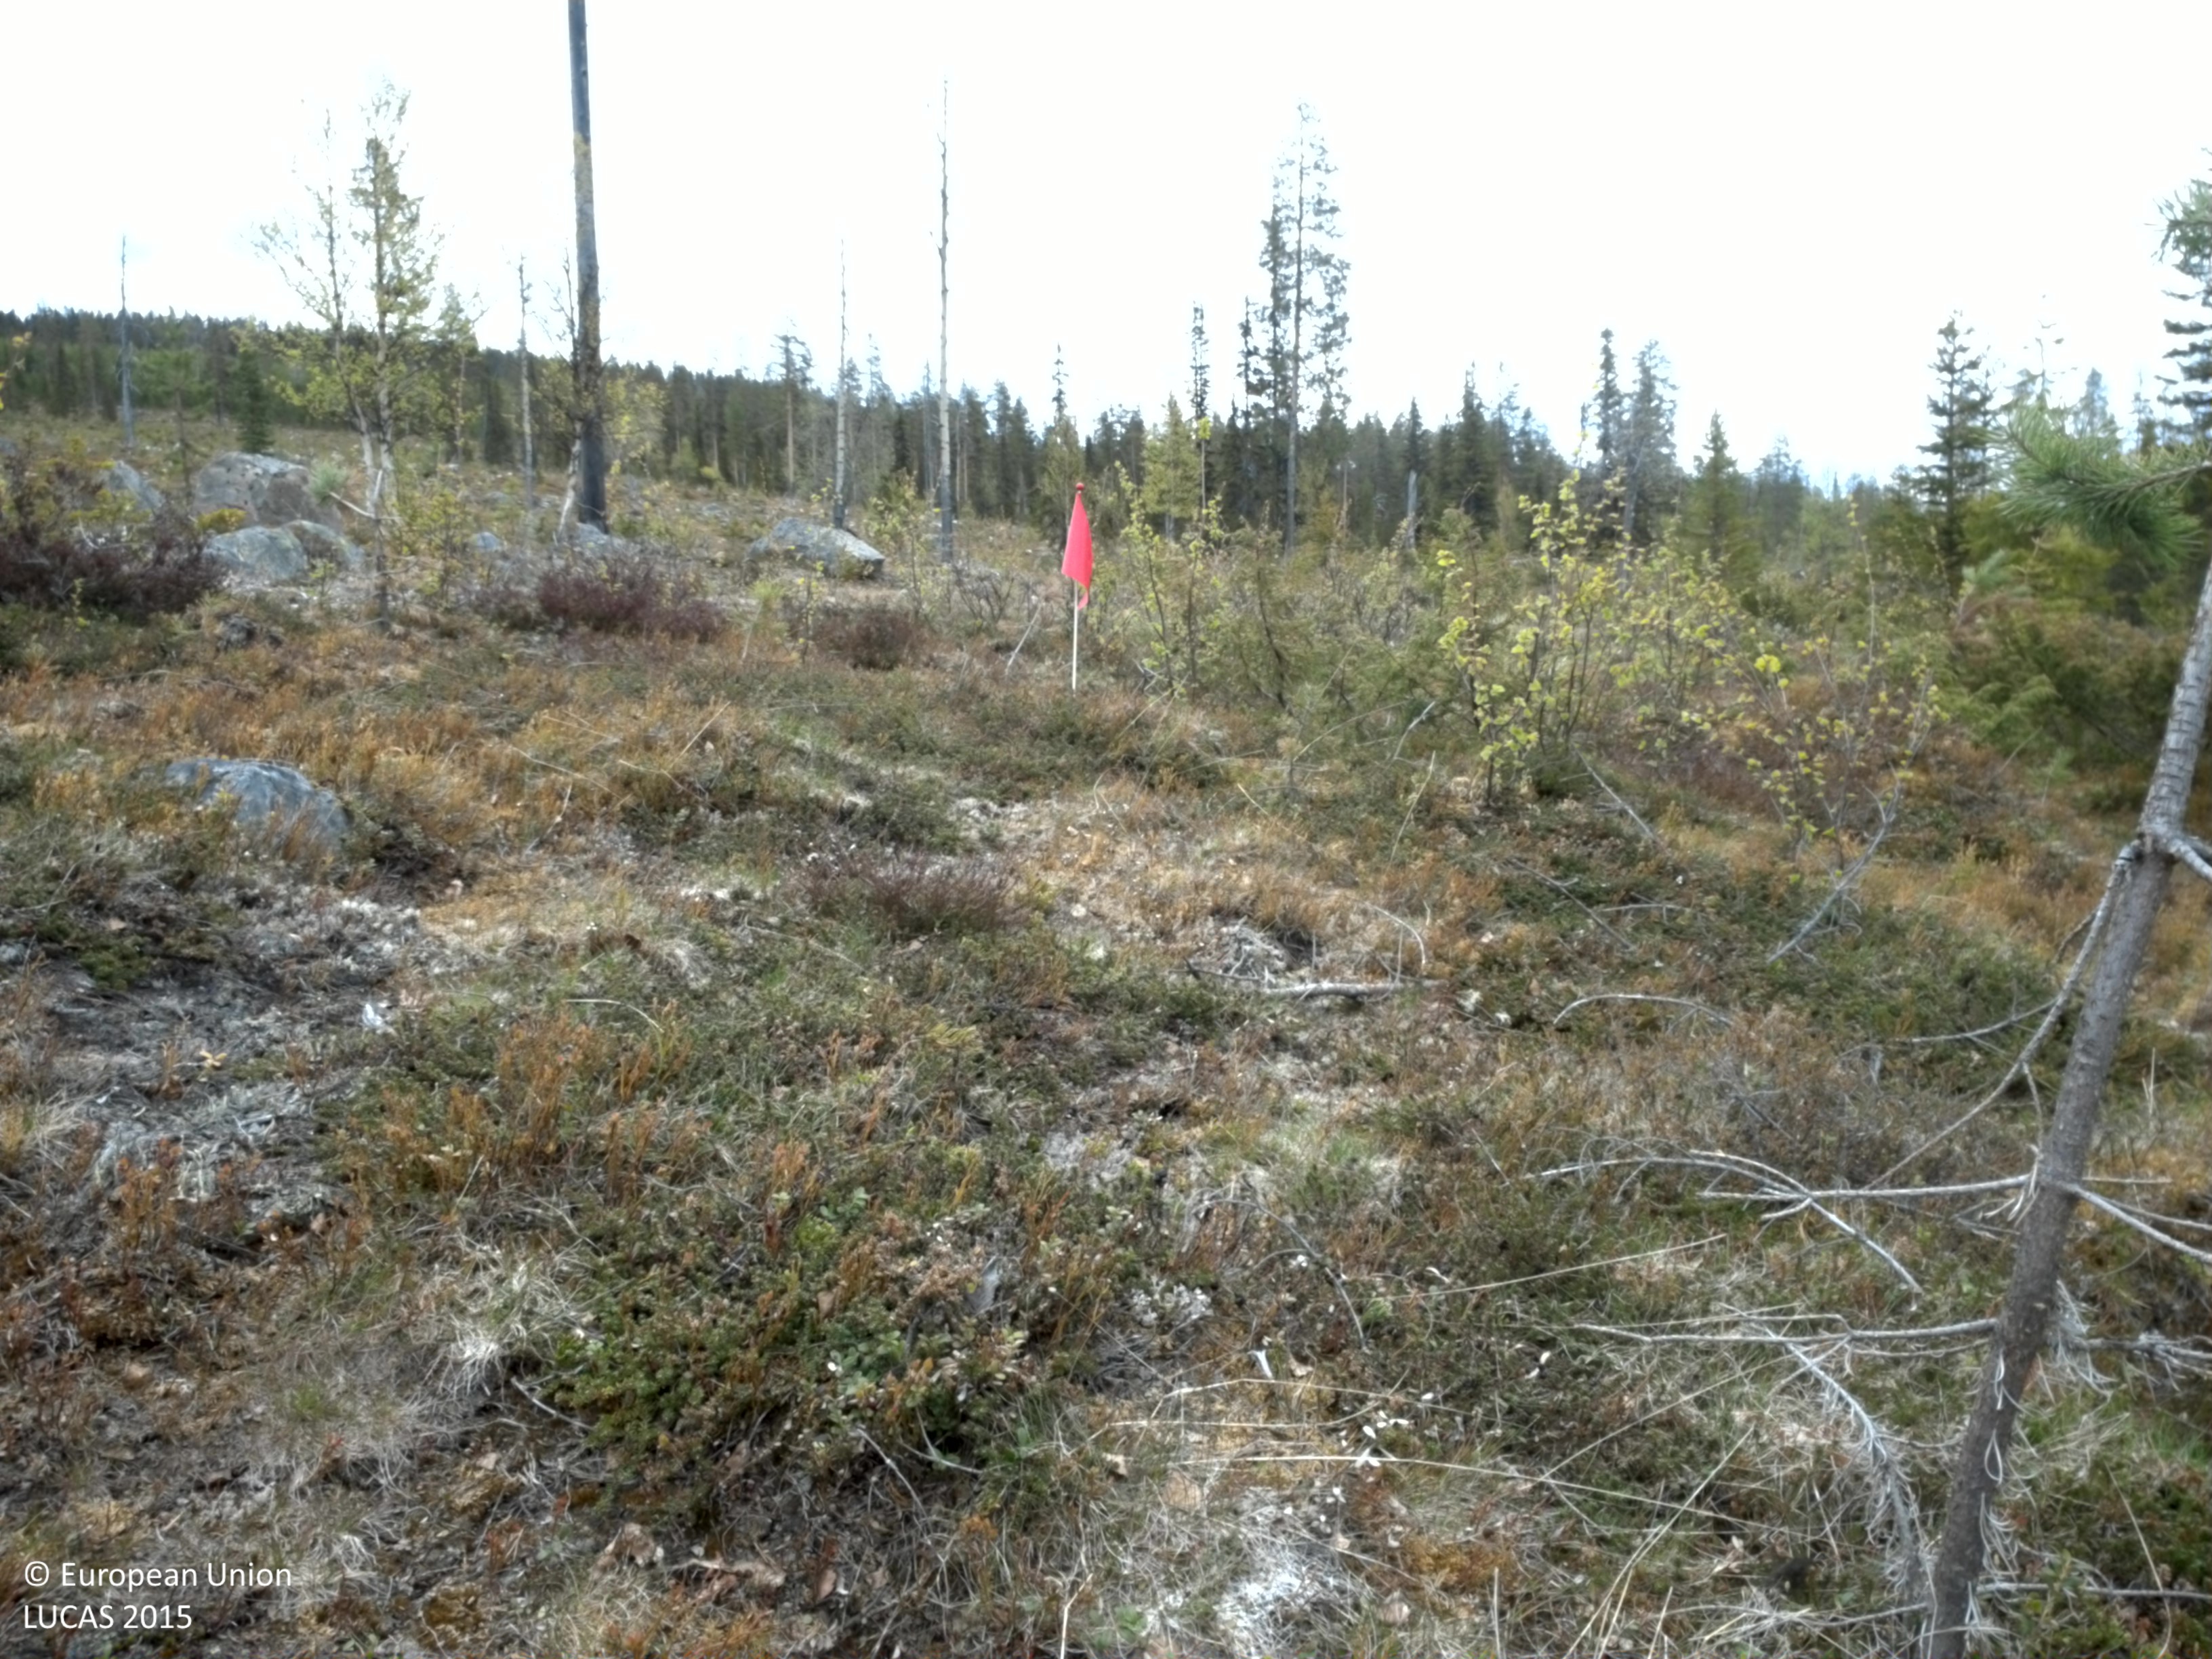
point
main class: Shrubland
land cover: Shrubland with sparse tree cover
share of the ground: > 75 %
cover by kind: shrubs 85 %, herbaceous plants 10 %, coniferous forest trees 5 %
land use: Forestry
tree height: < 5 m
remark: Clear cut
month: June
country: SE
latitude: 66.0399
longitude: 18.5839
